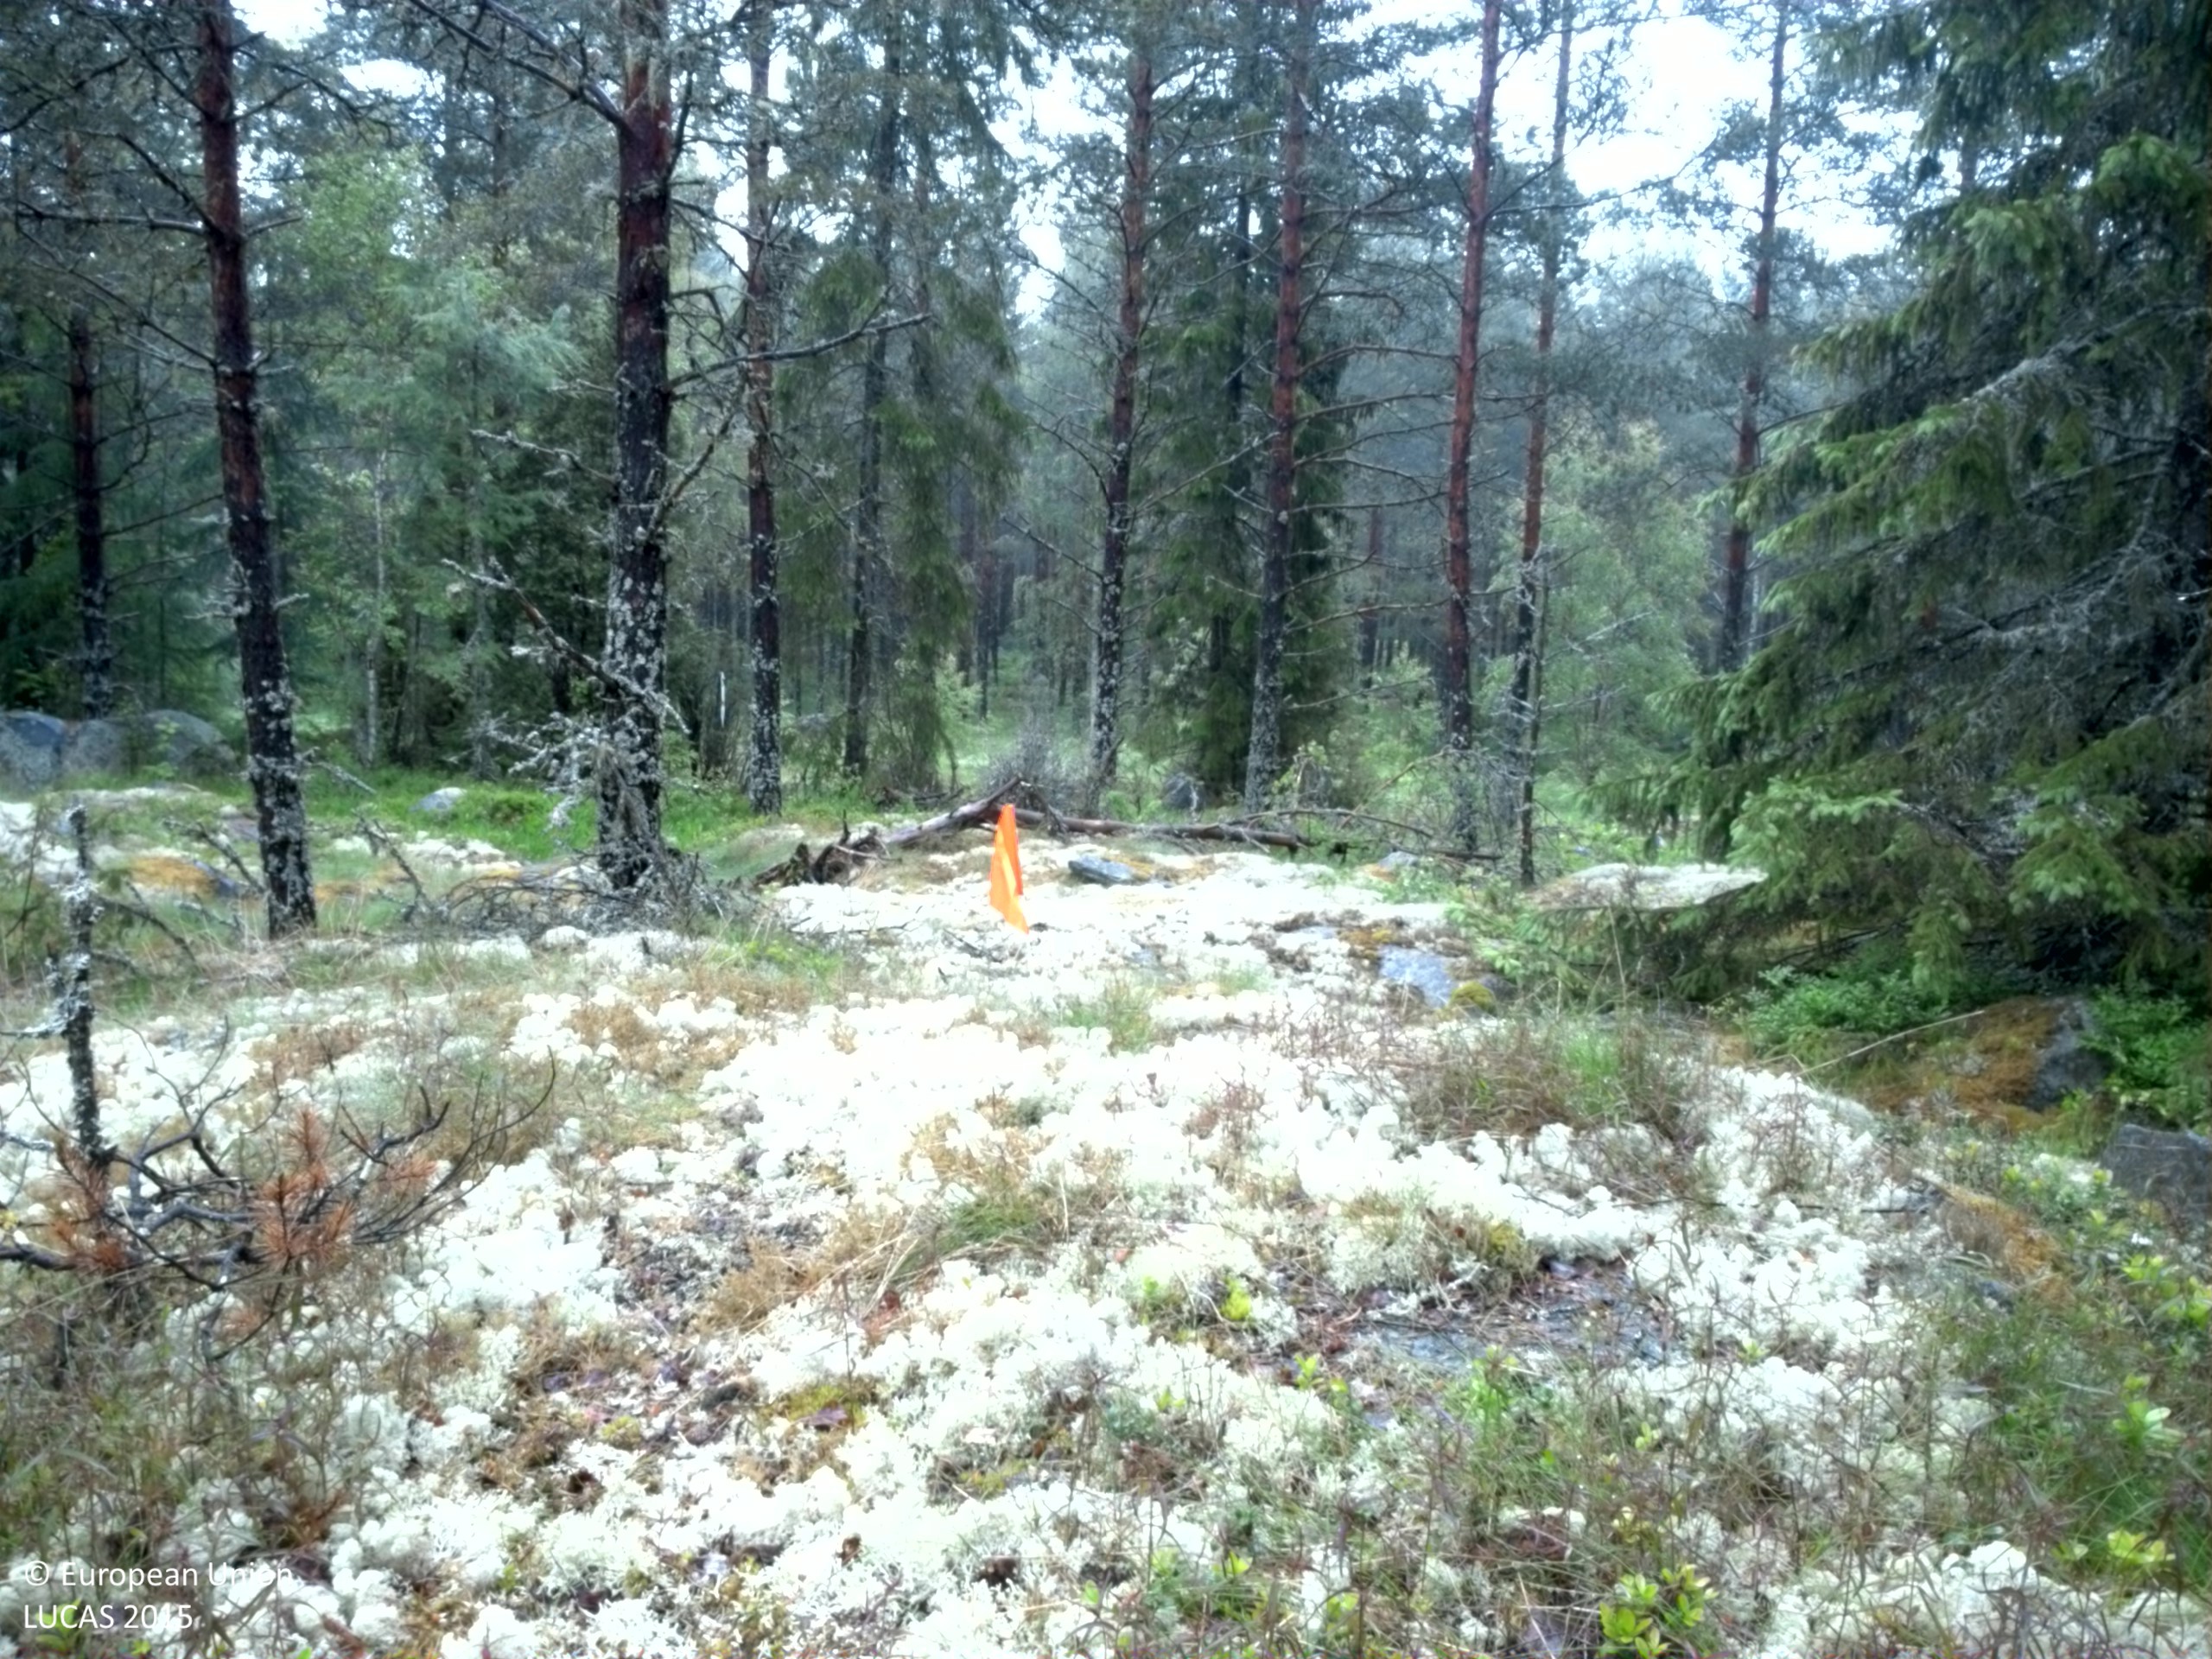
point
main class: Woodland
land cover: Pine dominated coniferous woodland
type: boreal forest
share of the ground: 50 - 75 %
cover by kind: coniferous forest trees 60 %, lichens and mosses 20 %, broadleaved forest trees 5 %, shrubs 5 %, herbaceous plants 5 %, consolidated bare surface 5 %
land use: Forestry
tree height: > 5 m
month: June
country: SE
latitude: 60.3643
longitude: 18.0978
